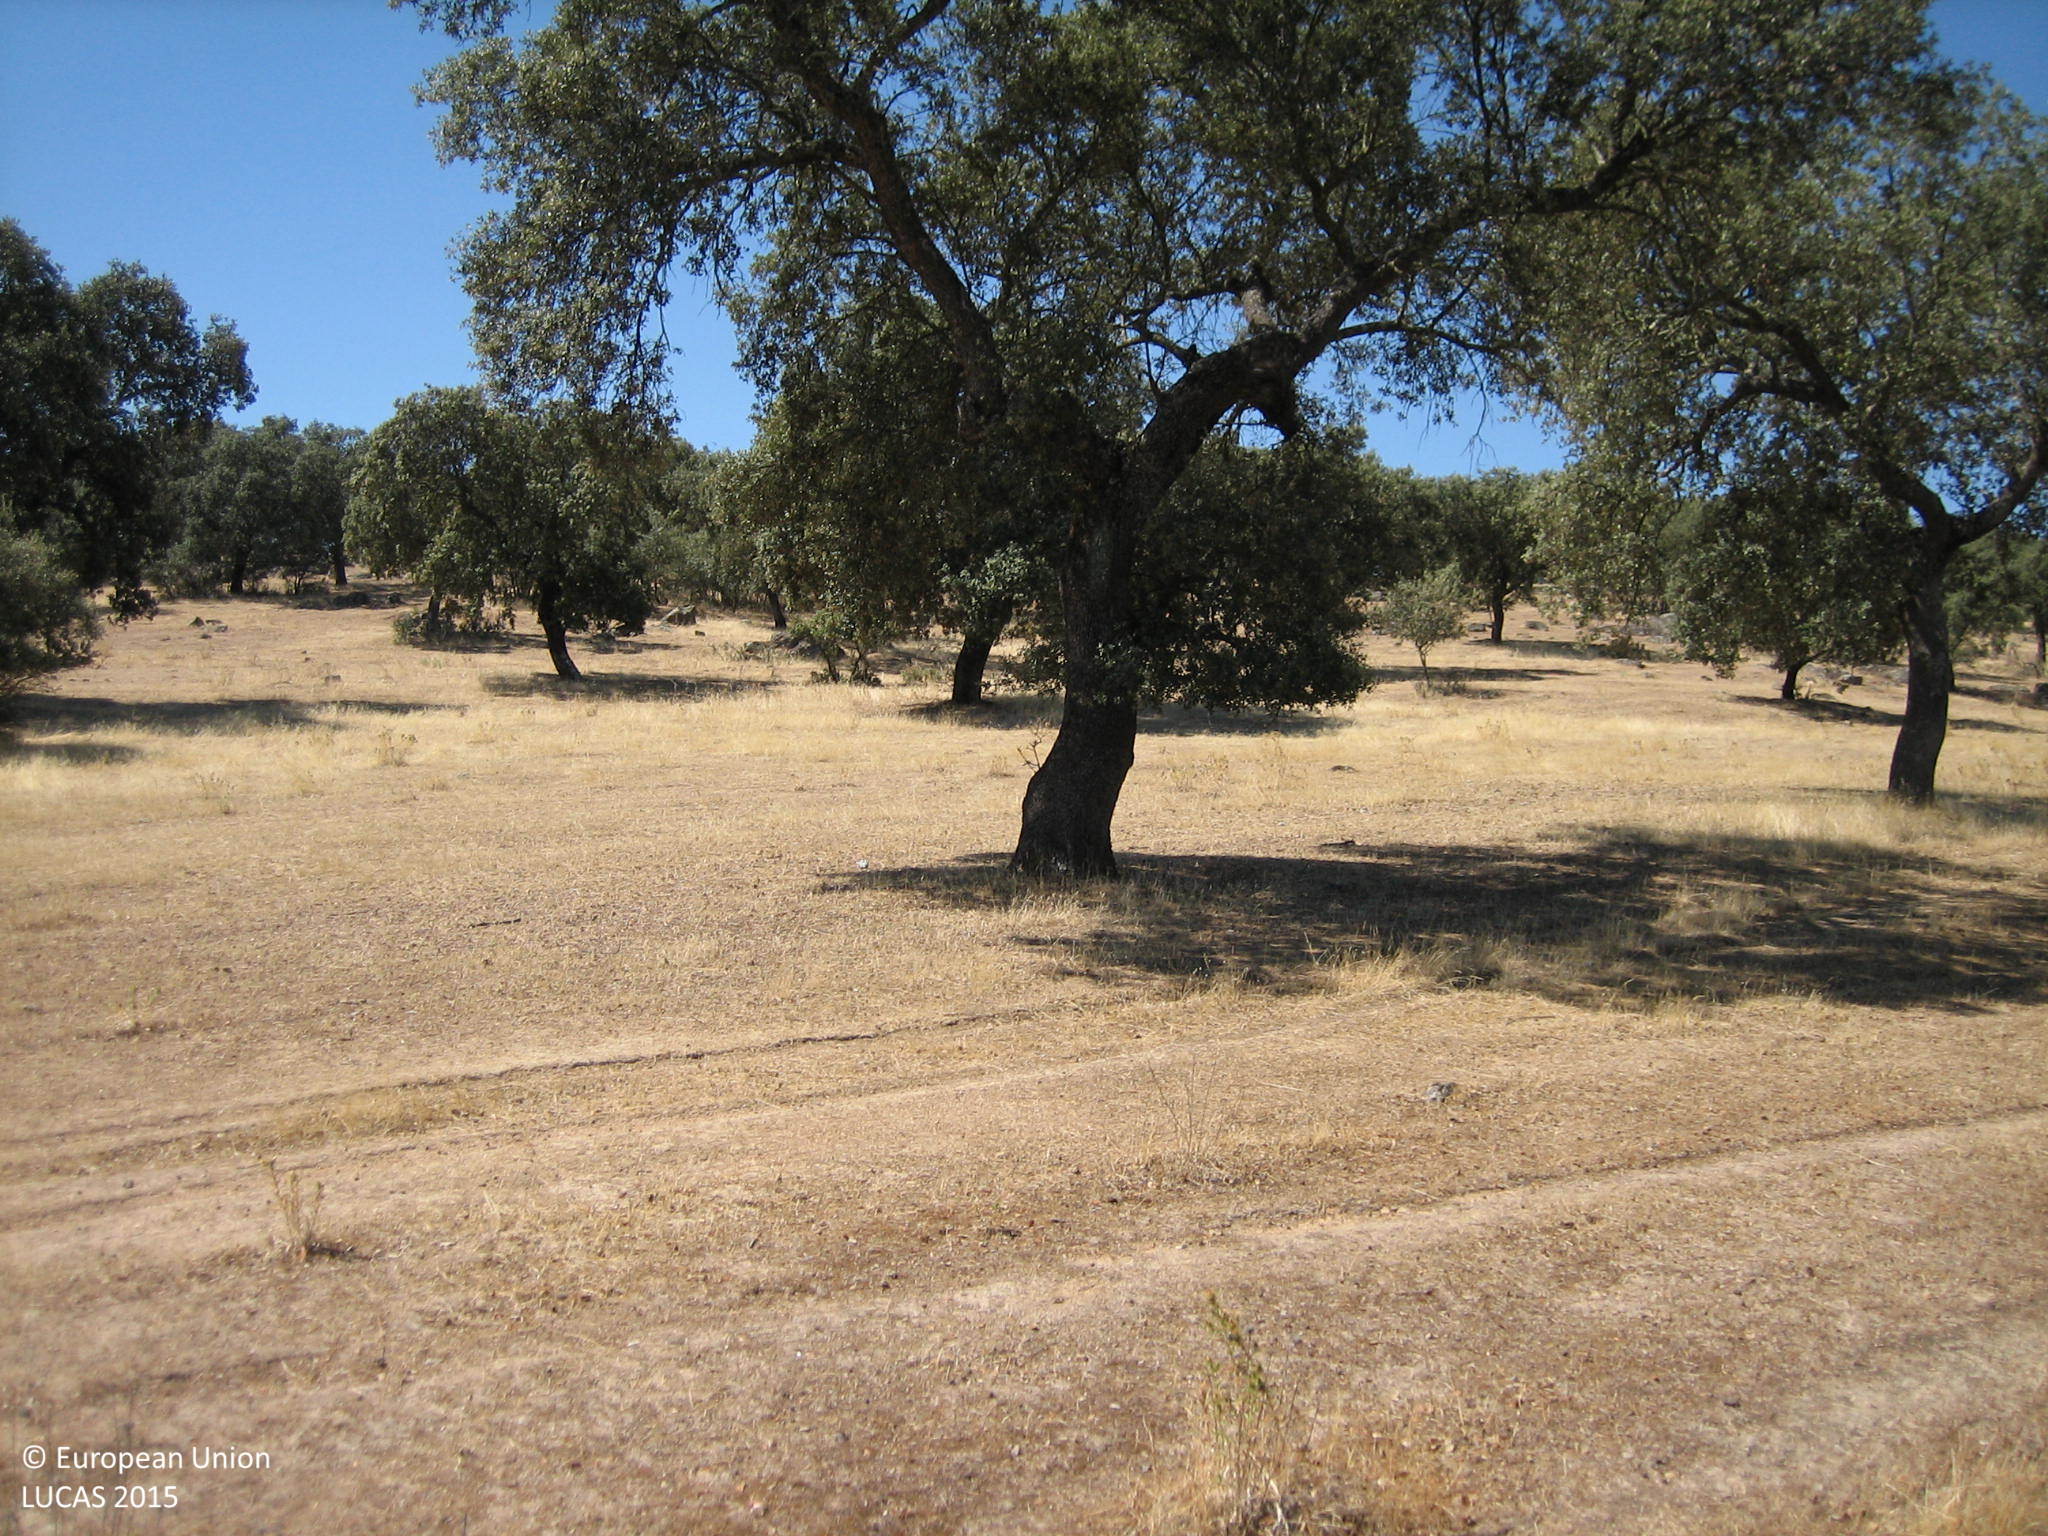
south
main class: Woodland
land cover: Broadleaved woodland
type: broadleaved evergreen forest
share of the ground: 10 - 25 %
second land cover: Grassland without tree/shrub cover
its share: 25 - 50 %
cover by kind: consolidated bare surface 50 %, herbaceous plants 30 %, broadleaved forest trees 20 %
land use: Forestry
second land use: Agriculture (excluding fallow land and kitchen gardens)
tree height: > 5 m
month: July
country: ES
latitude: 38.4948
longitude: -6.1558
